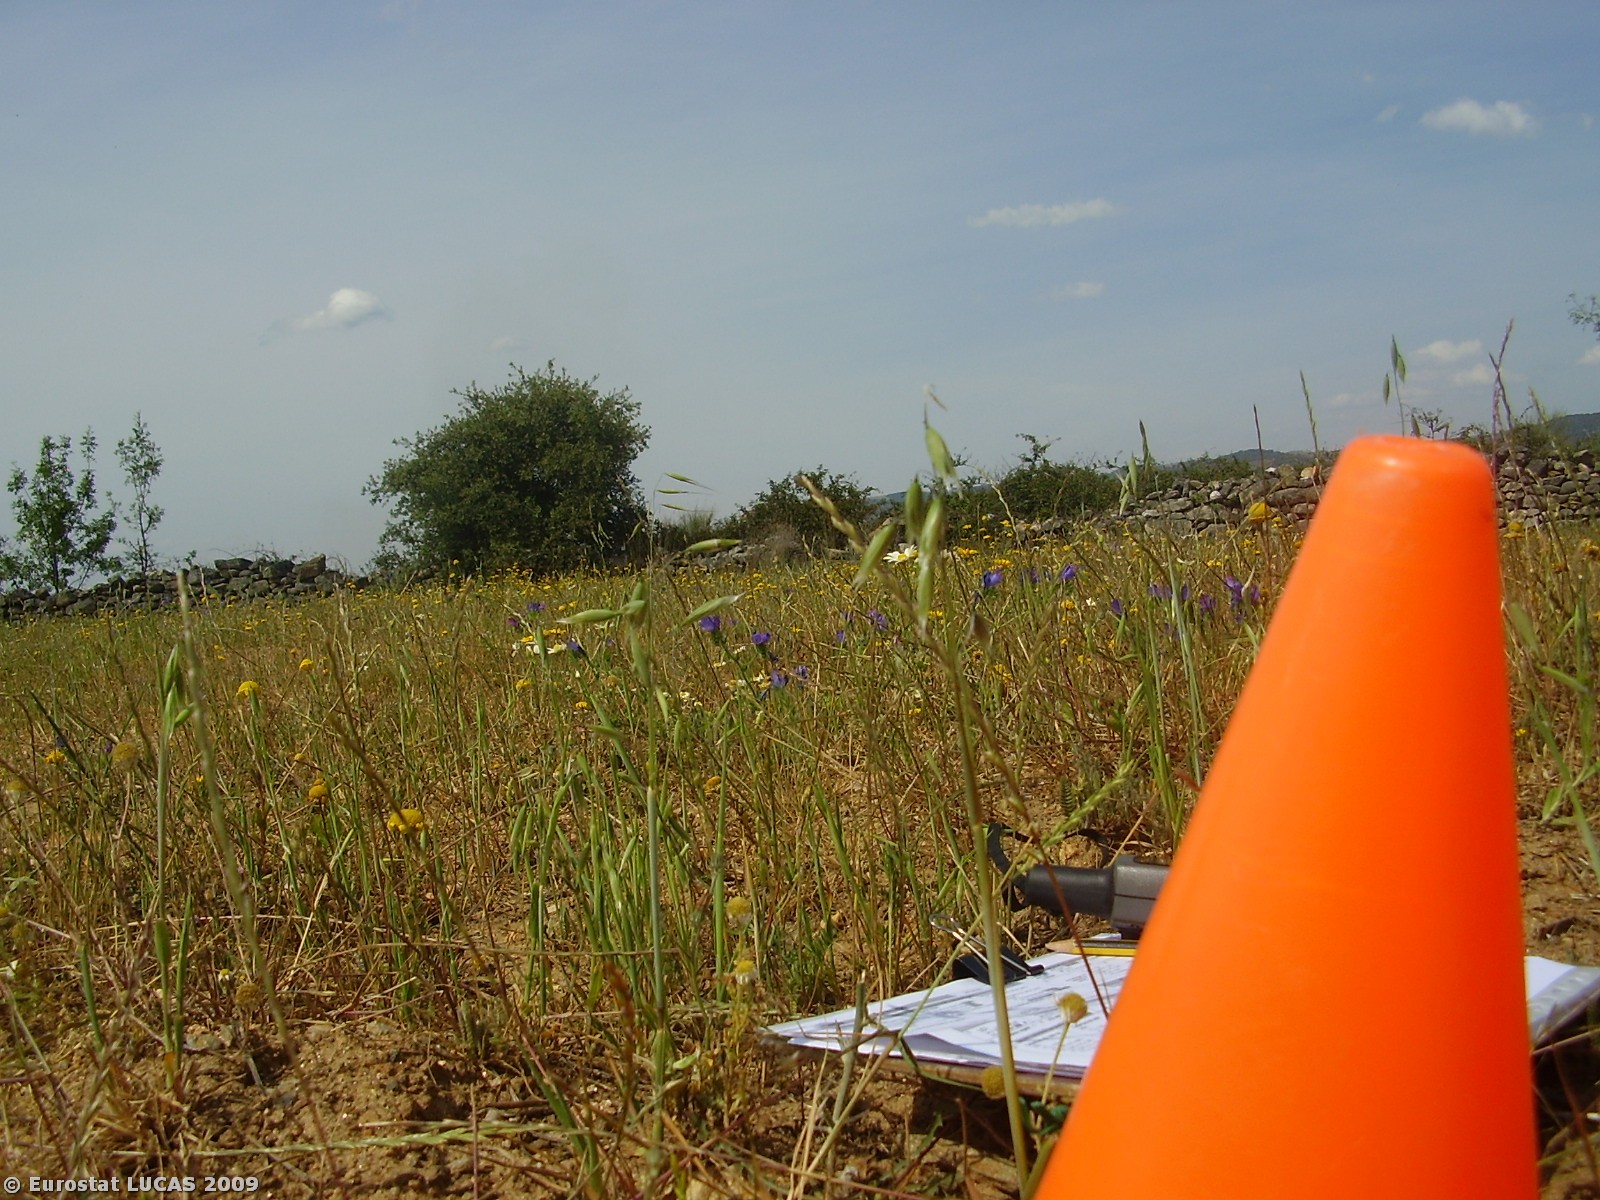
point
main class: Cropland
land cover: Mixed cereals for fodder
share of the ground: 50 - 75 %
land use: Agriculture (excluding fallow land and kitchen gardens)
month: May
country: PT
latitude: 41.5097
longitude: -7.0453
